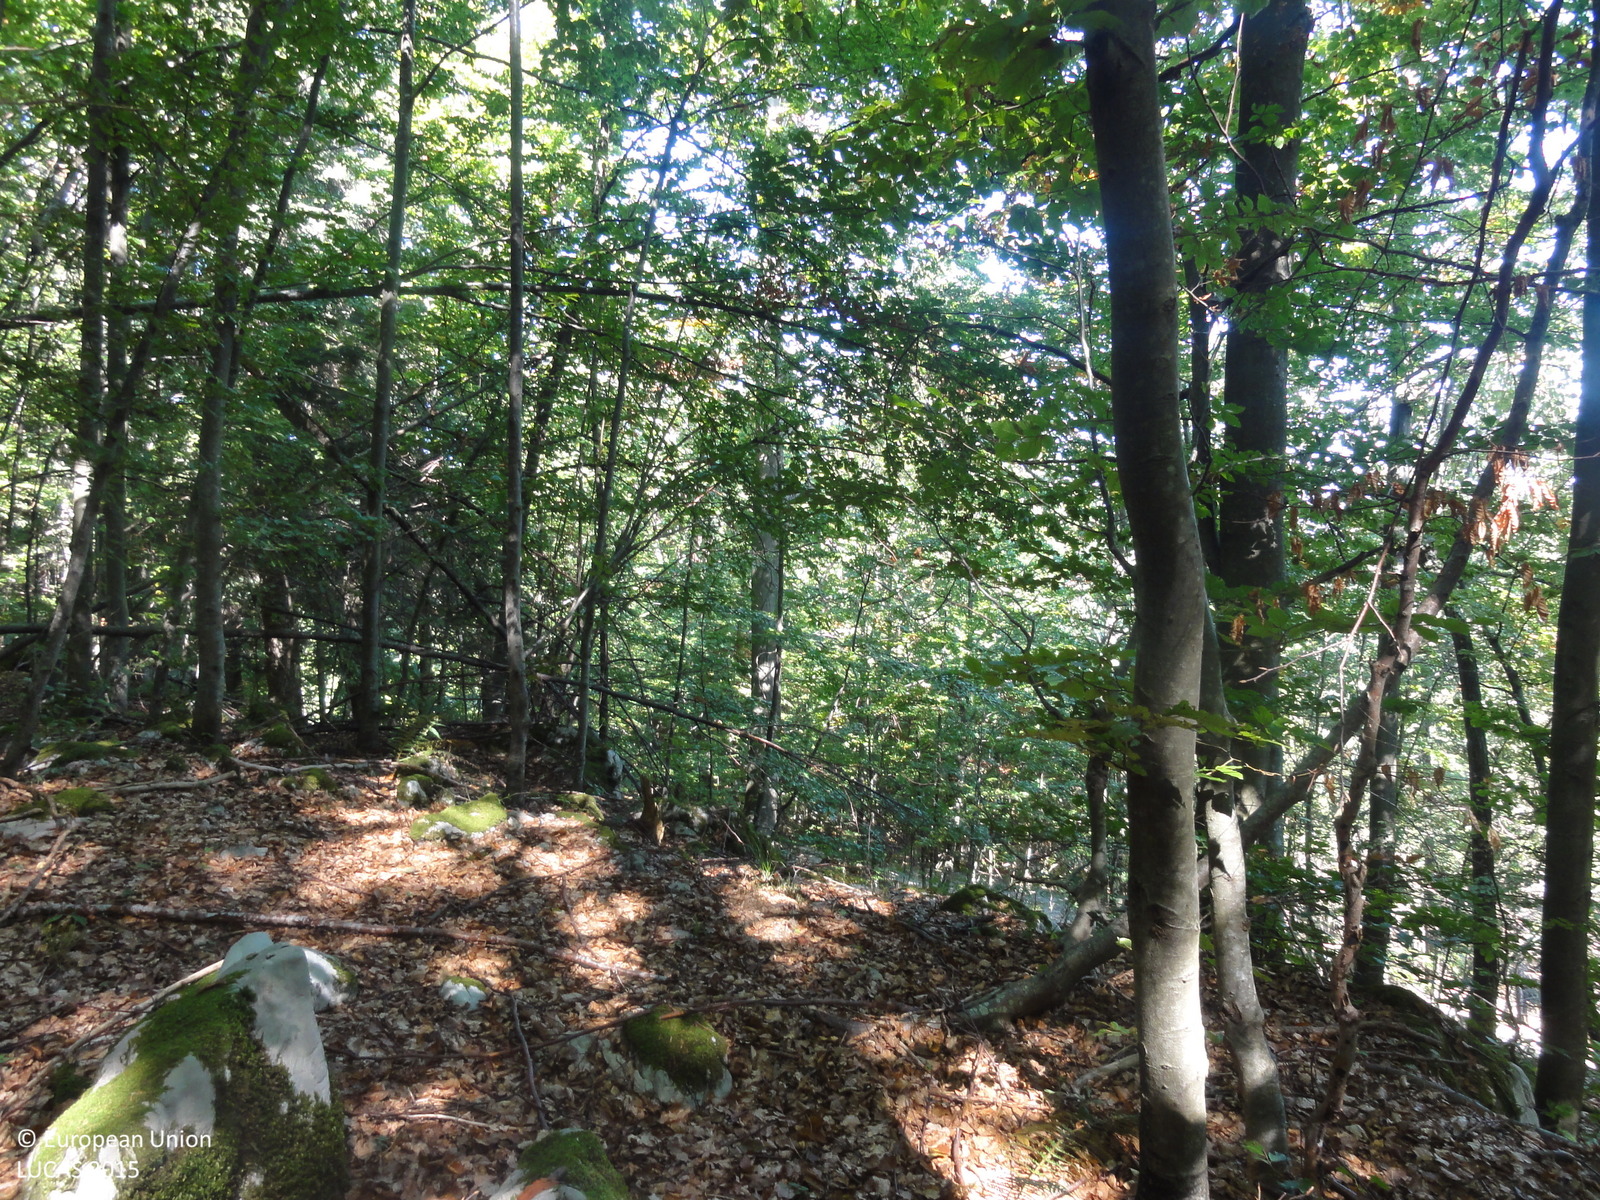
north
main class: Woodland
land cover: Broadleaved woodland
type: beech forest
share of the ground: > 75 %
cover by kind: broadleaved forest trees 90 %, coniferous forest trees 5 %, unconsolidated bare surface 5 %
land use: Forestry
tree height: > 5 m
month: September
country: SI
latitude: 45.7652
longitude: 14.9981
